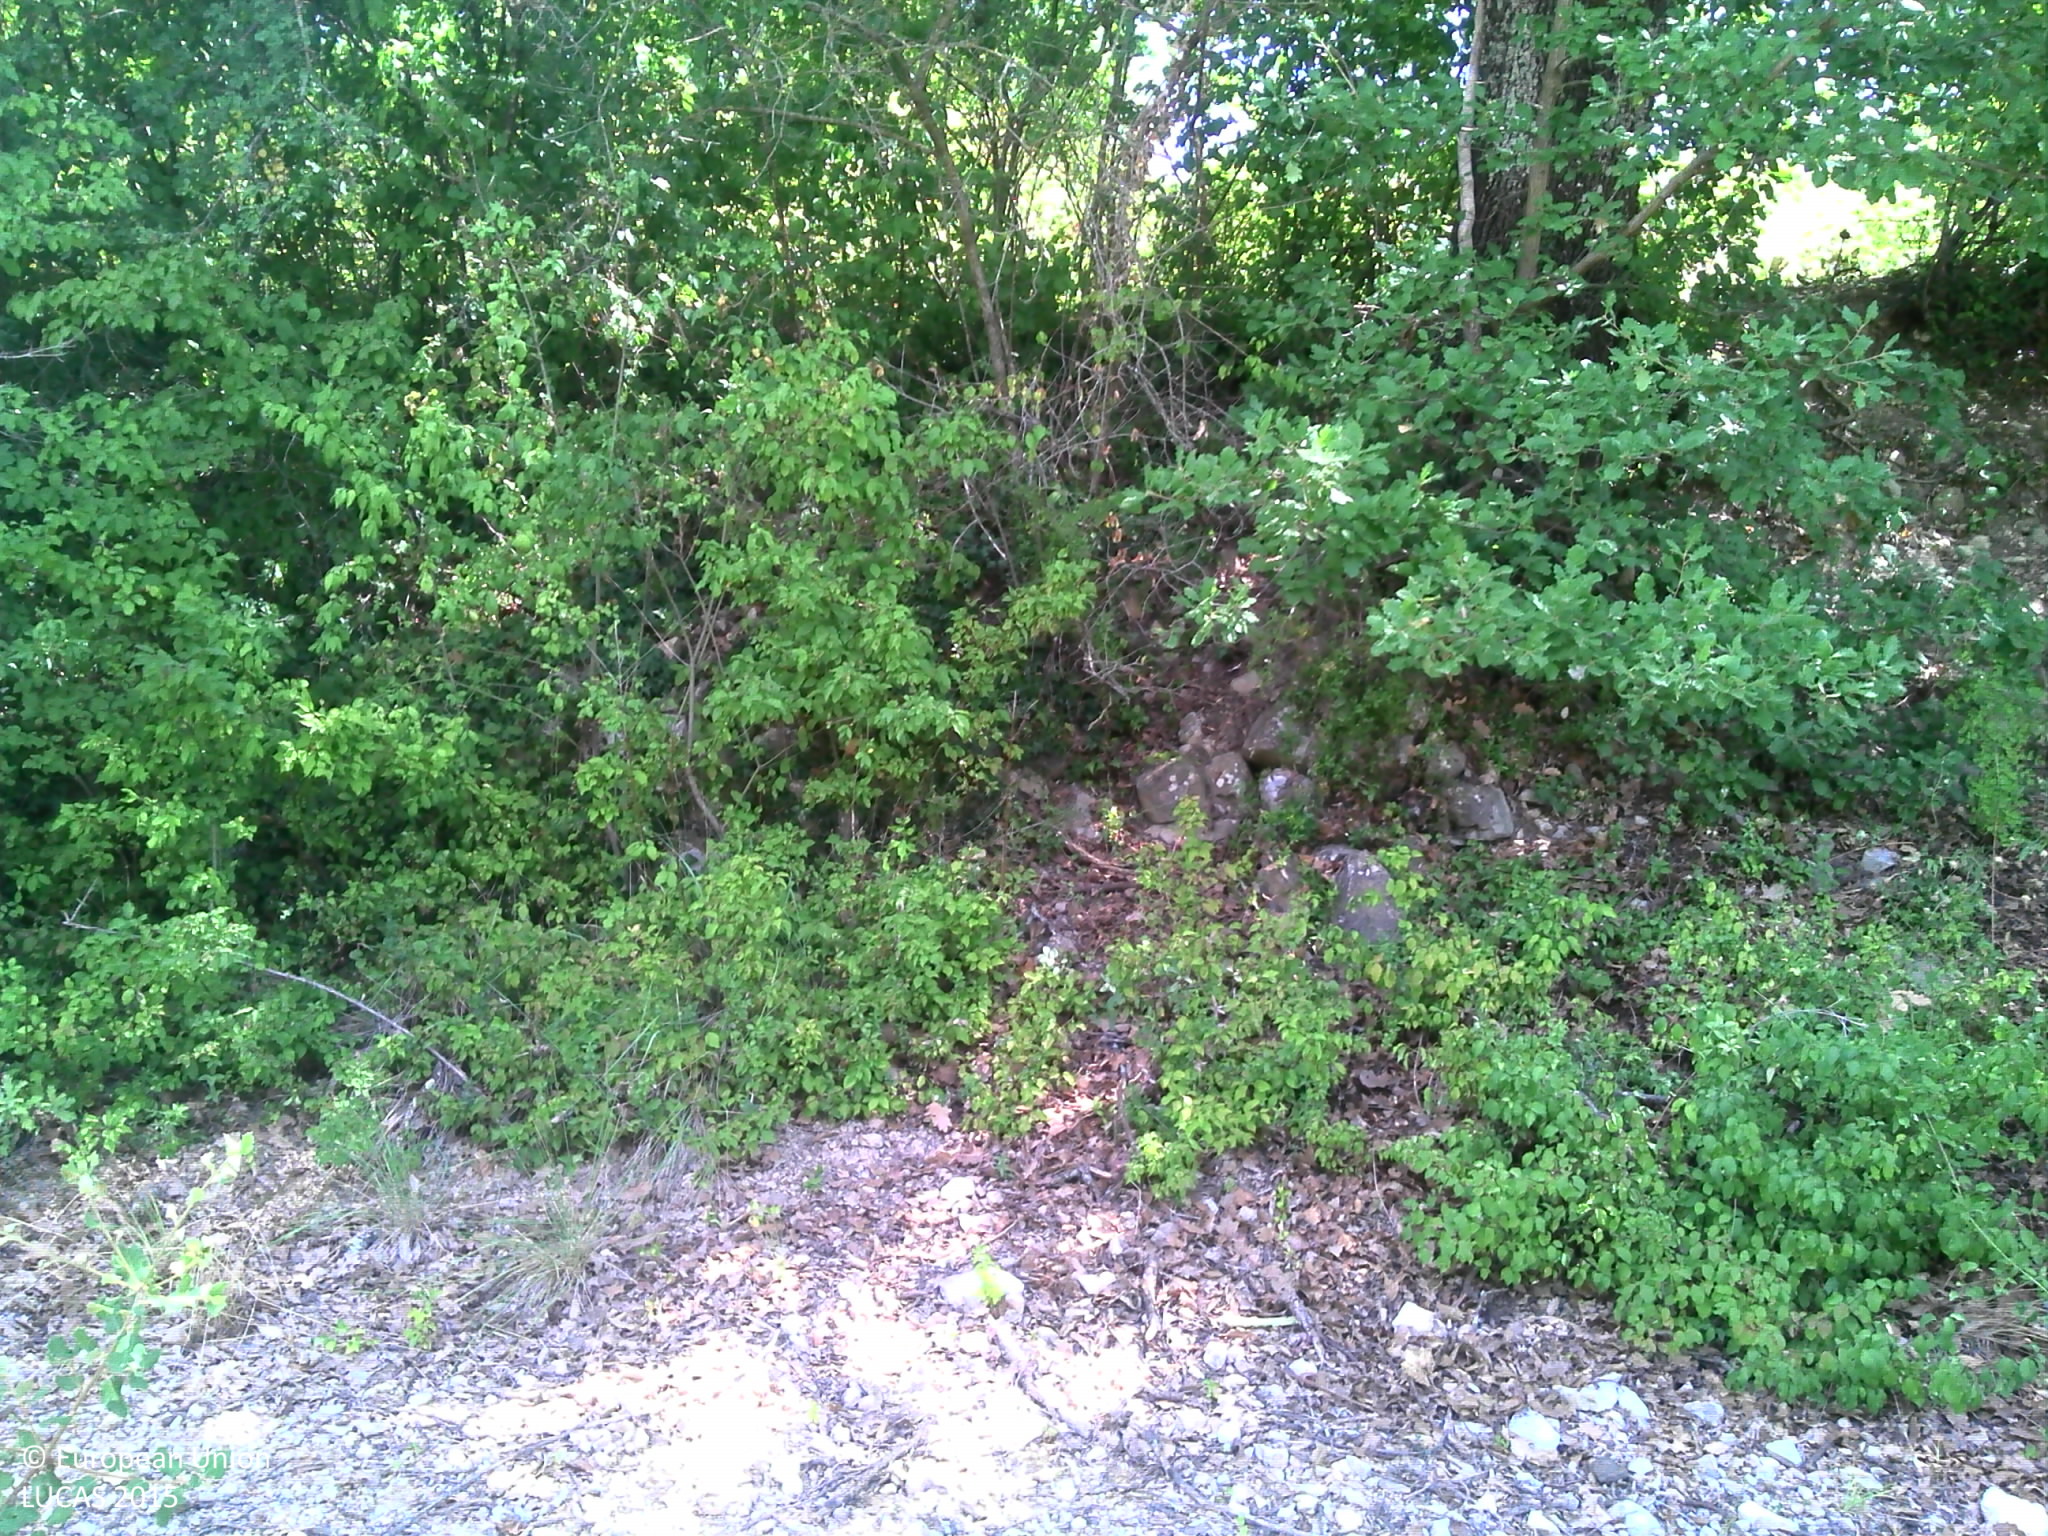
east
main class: Grassland
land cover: Spontaneously vegetated surfaces
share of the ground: 25 - 50 %
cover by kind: herbaceous plants 50 %, unconsolidated bare surface 50 %
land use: Fallow land
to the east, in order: Spontaneously vegetated surfaces; Broadleaved woodland; Grassland with sparse tree/shrub cover; Fences; Grassland with sparse tree/shrub cover; Artificial constructions in urban areas; Broadleaved woodland; Grassland with sparse tree/shrub cover; Broadleaved woodland
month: July
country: FR
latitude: 44.5536
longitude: 4.6061
